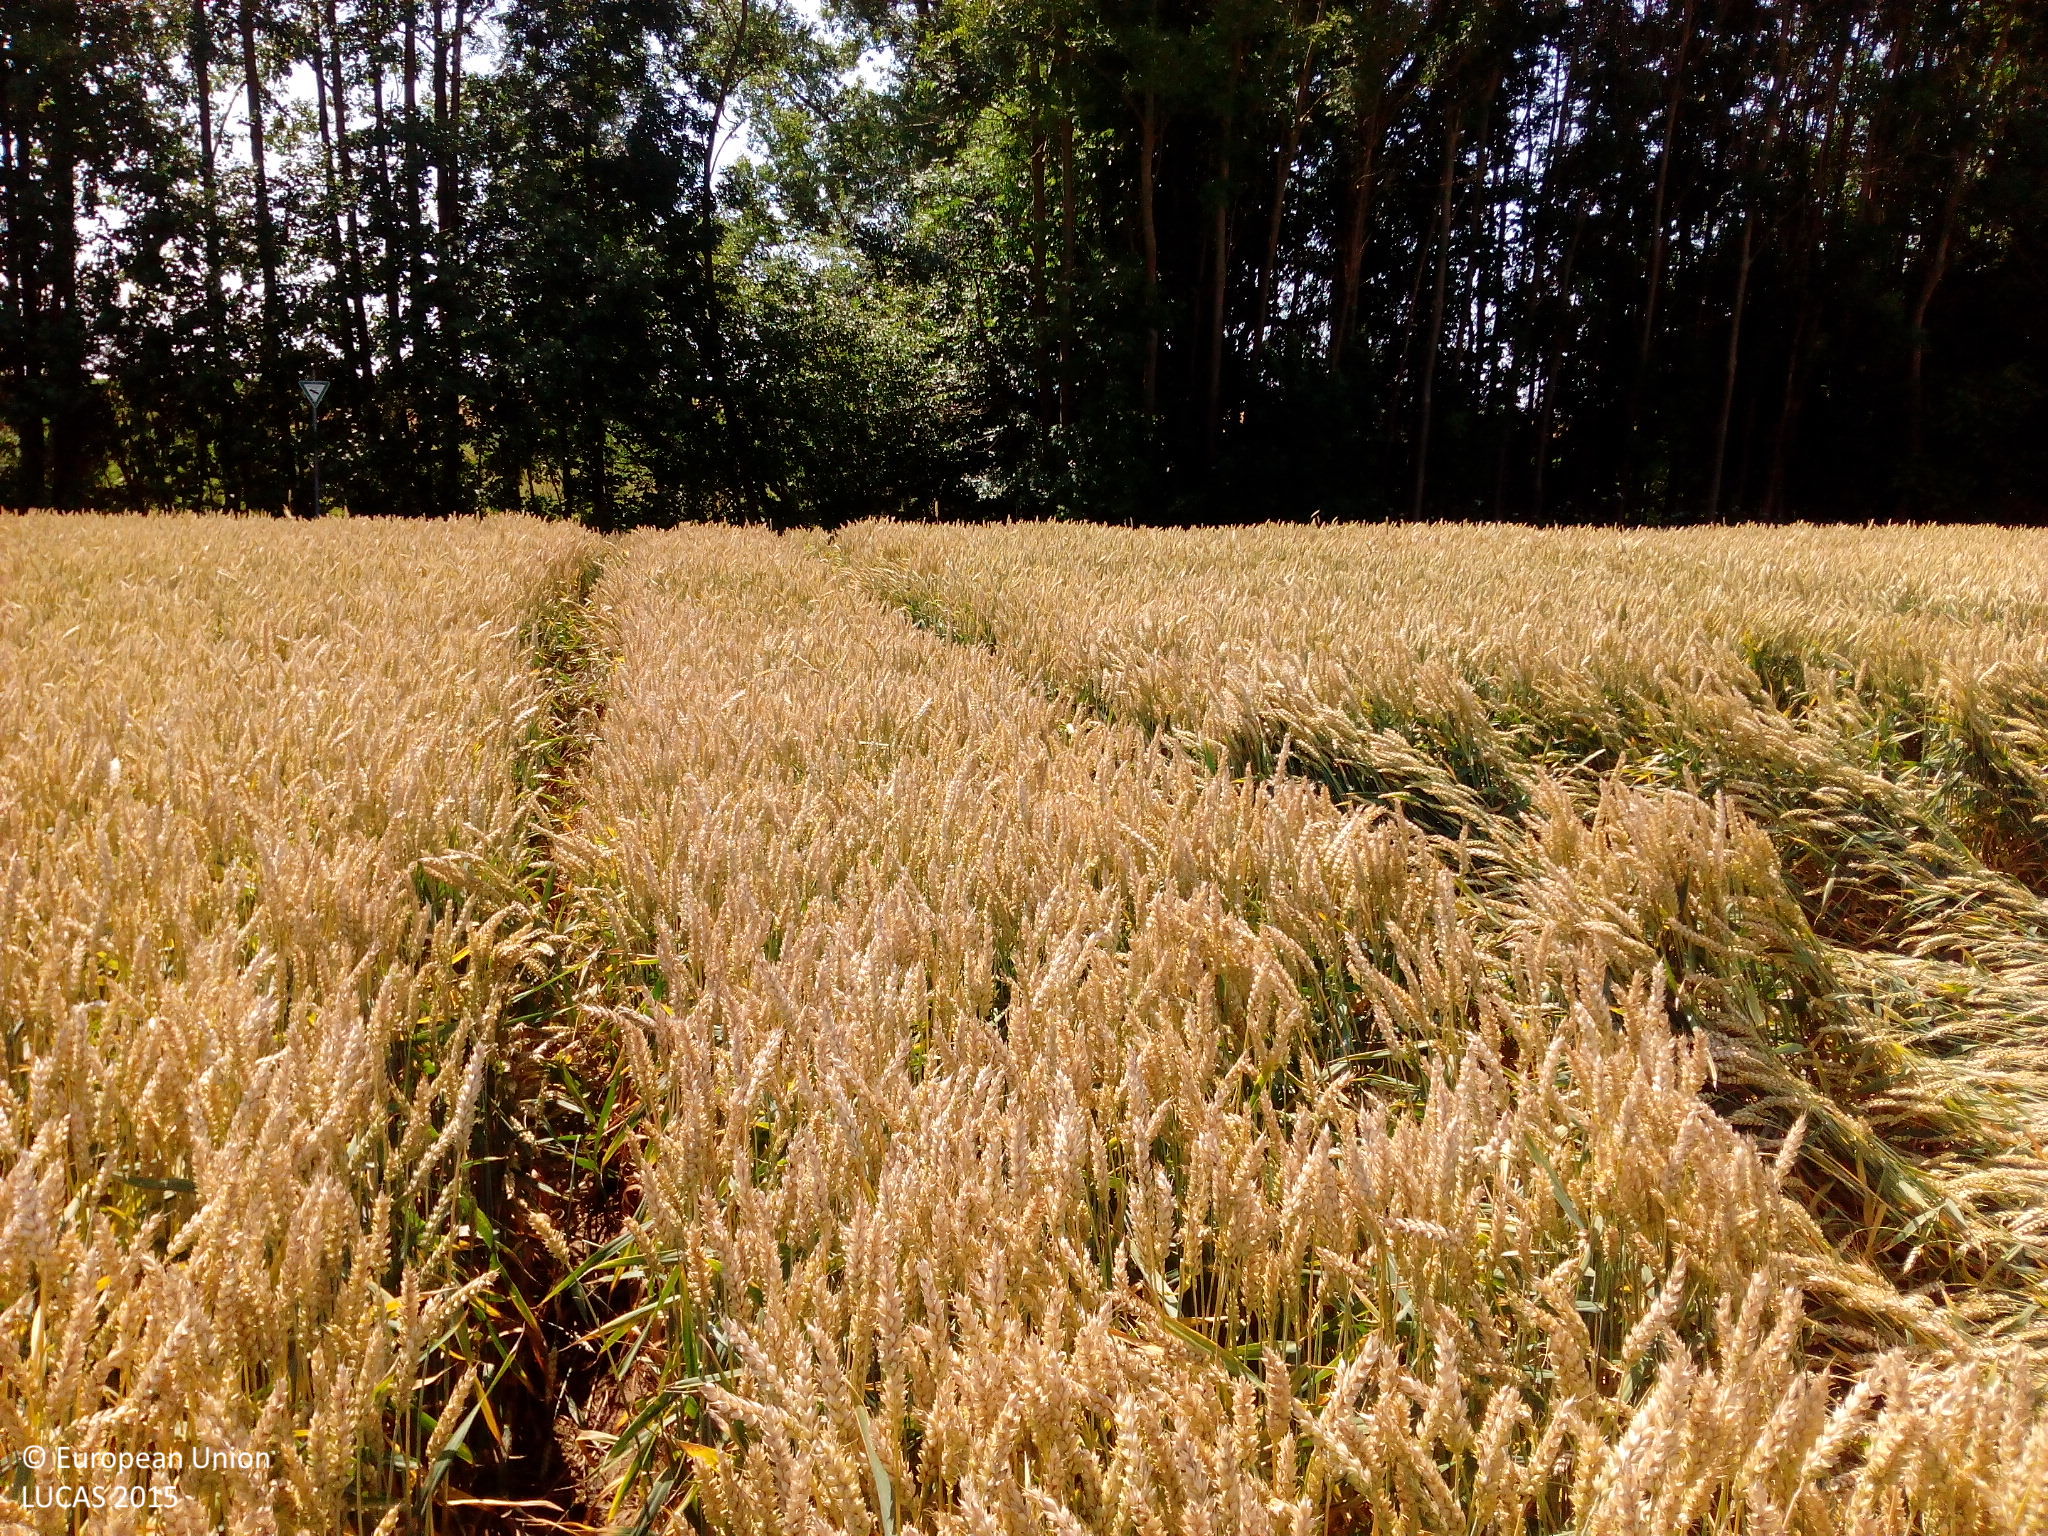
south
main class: Cropland
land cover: Common wheat
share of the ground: > 75 %
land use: Agriculture (excluding fallow land and kitchen gardens)
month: July
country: DE
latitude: 49.6267
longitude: 9.9585
